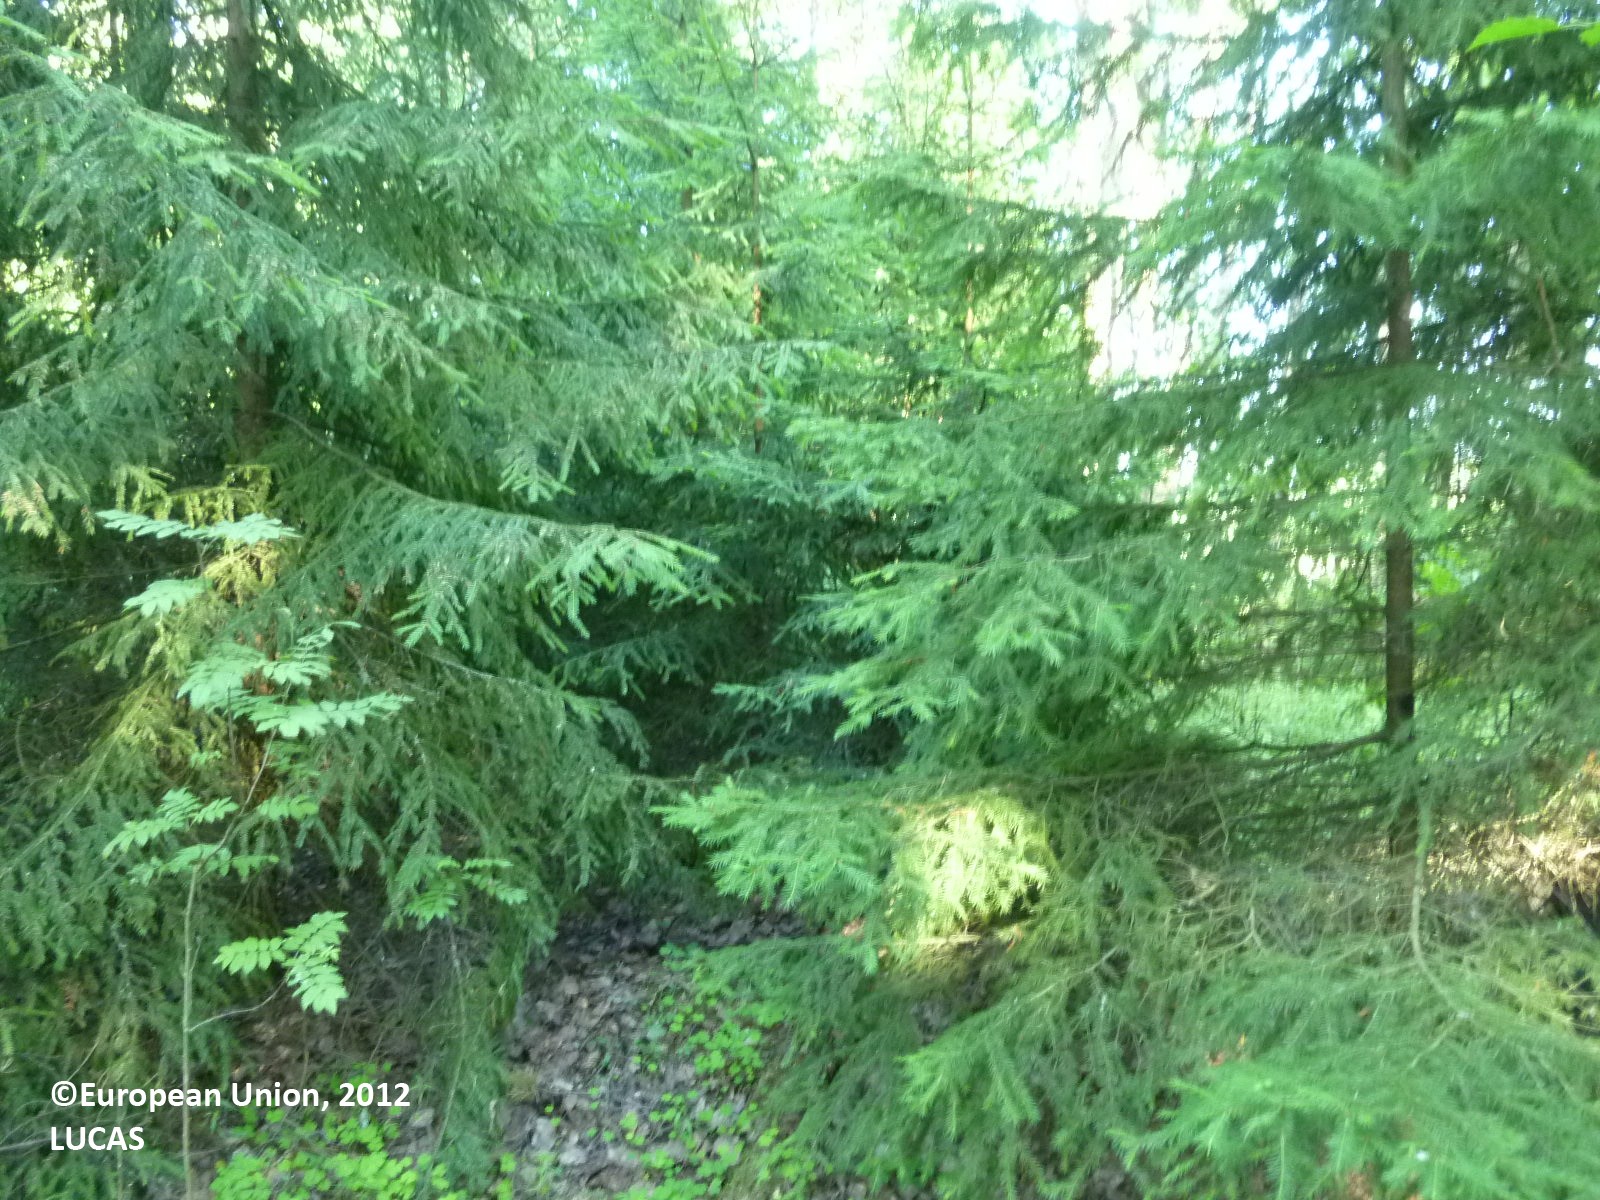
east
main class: Woodland
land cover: Broadleaved woodland
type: boreal forest
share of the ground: 50 - 75 %
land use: Forestry
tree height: > 5 m
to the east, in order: Broadleaved woodland; Ditches and canals; Grassland without tree/shrub cover; Grass margins; Sugar beet; Grass margins; Ditches and canals; Grass margins; Oats
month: July
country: FI
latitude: 61.3418
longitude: 22.0397
